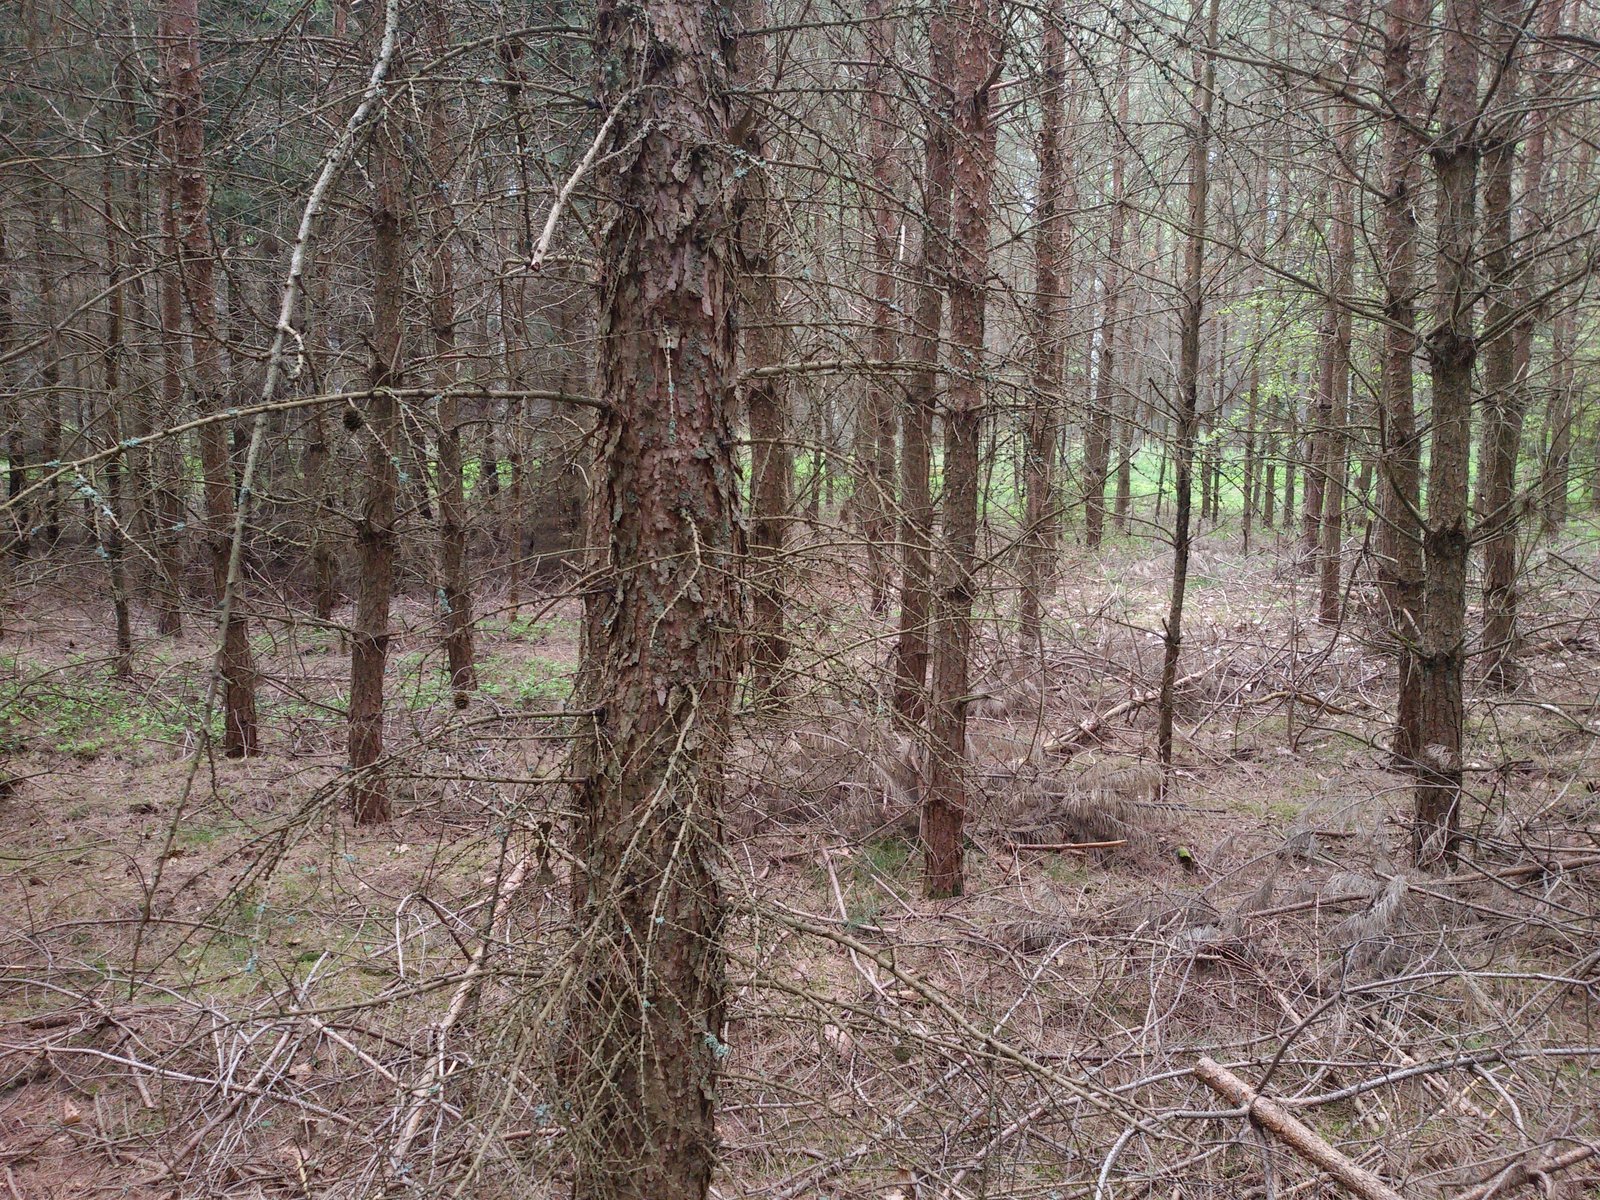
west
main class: Woodland
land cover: Pine dominated coniferous woodland
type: hemiboreal forest and nemoral coniferous forest and mixed broadleaved-coniferous forest
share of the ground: > 75 %
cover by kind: coniferous forest trees 90 %, lichens and mosses 10 %
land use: Forestry
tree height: > 5 m
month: May
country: PL
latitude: 53.4175
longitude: 17.2779
